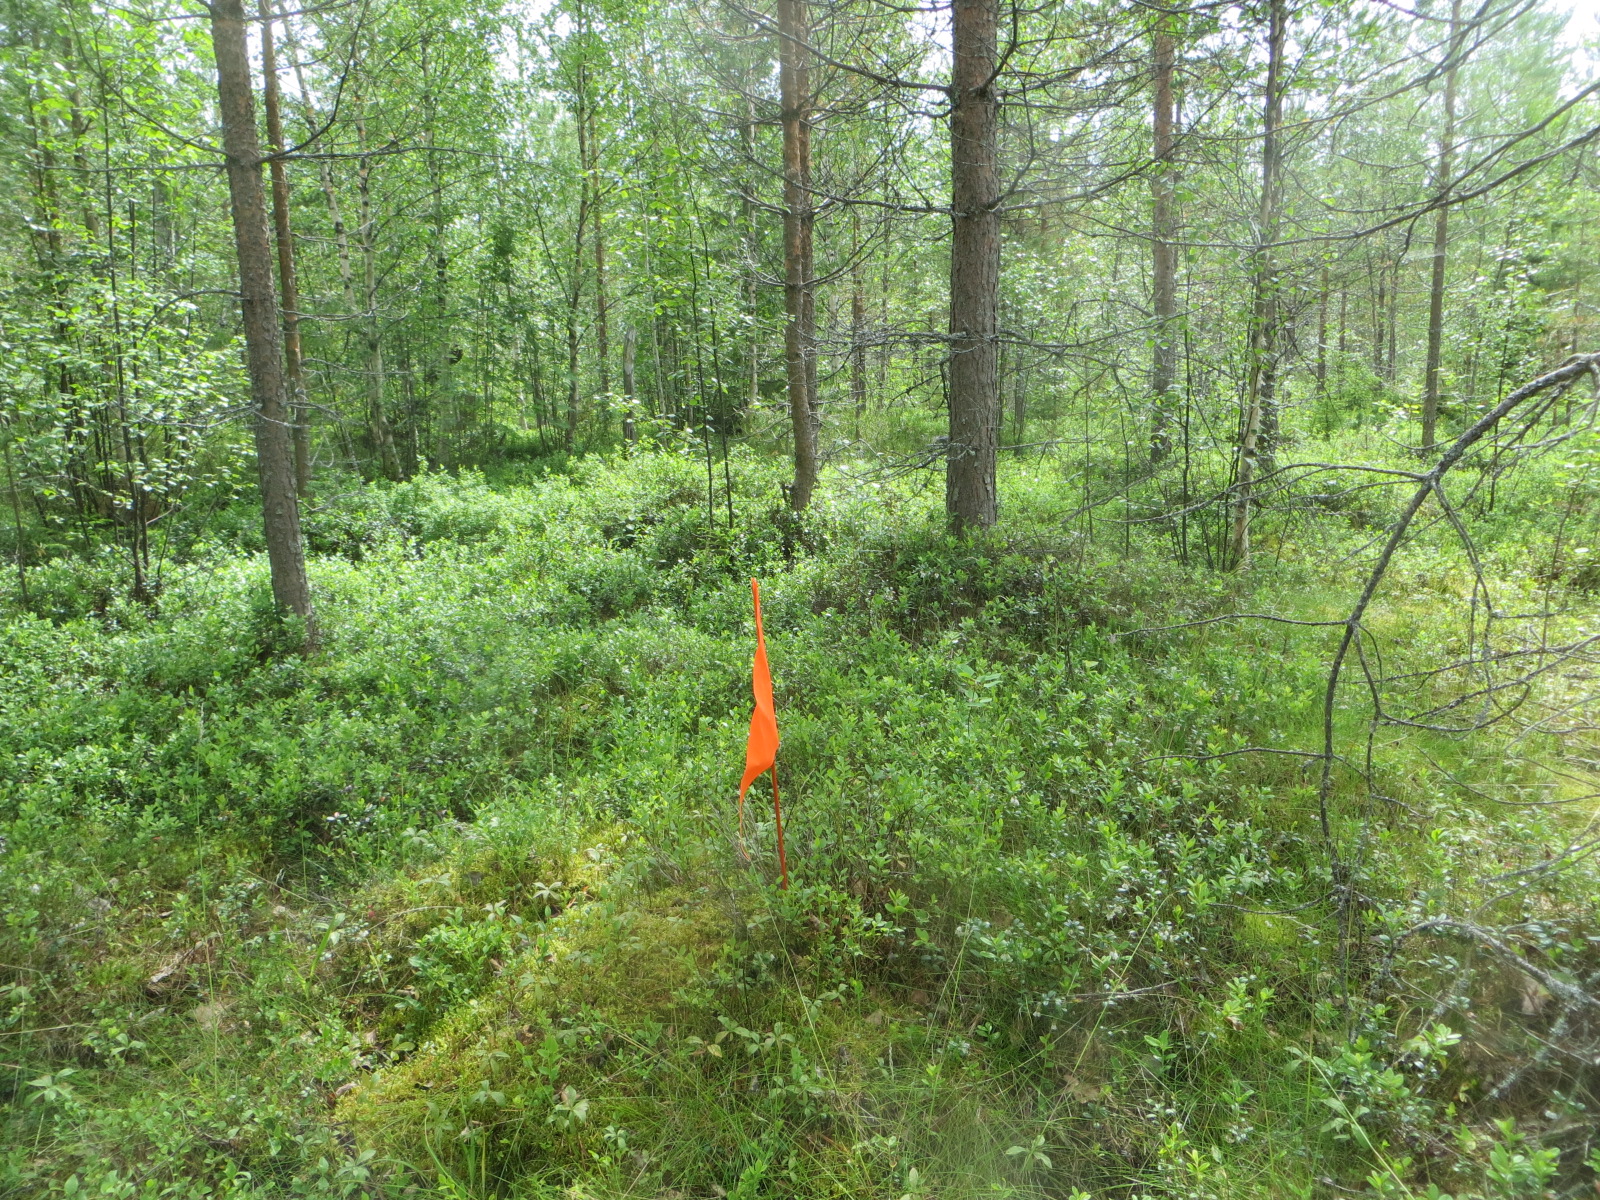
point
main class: Woodland
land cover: Pine dominated mixed woodland
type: boreal forest
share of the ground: > 75 %
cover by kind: coniferous forest trees 50 %, shrubs 30 %, broadleaved forest trees 20 %
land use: Forestry
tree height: > 5 m
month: July
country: FI
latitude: 65.6111
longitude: 25.2855
